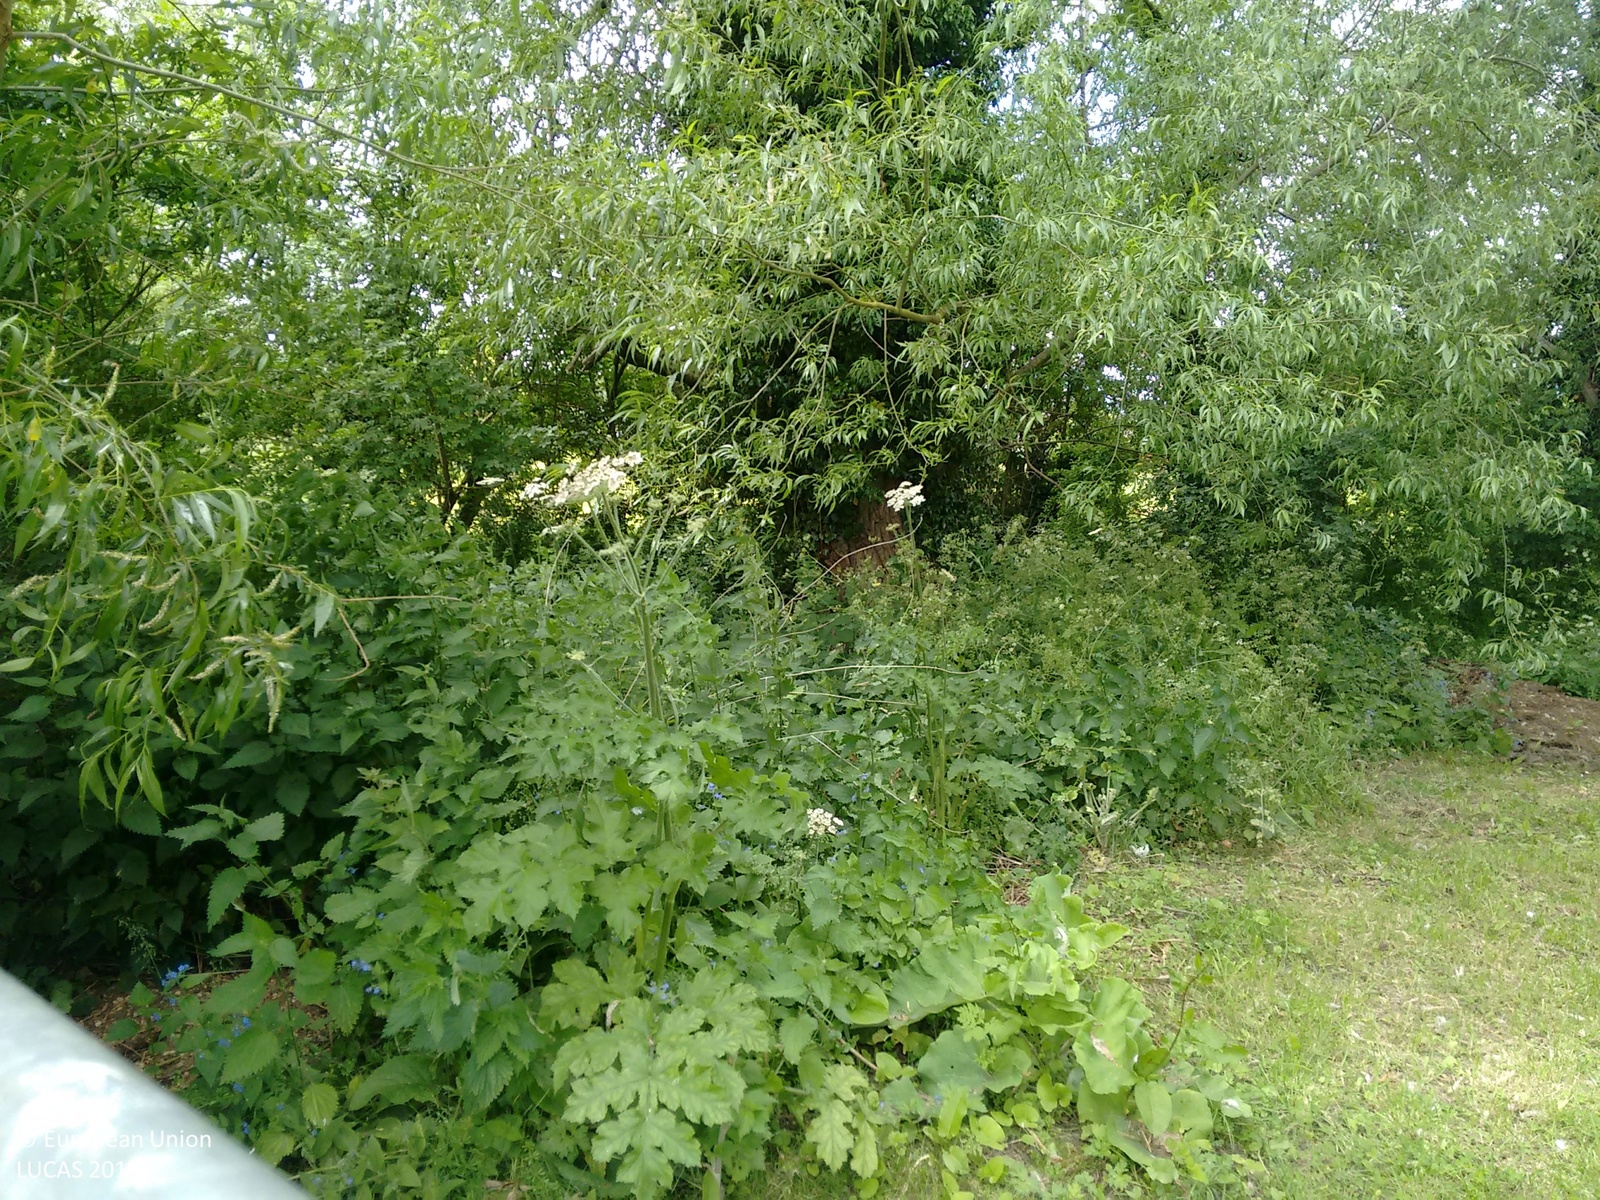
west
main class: Grassland
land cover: Grassland with sparse tree/shrub cover
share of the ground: > 75 %
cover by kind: herbaceous plants 95 %, broadleaved forest trees 5 %
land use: Agriculture (excluding fallow land and kitchen gardens)
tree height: > 5 m
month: June
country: GB
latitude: 52.1122
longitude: -1.6327
